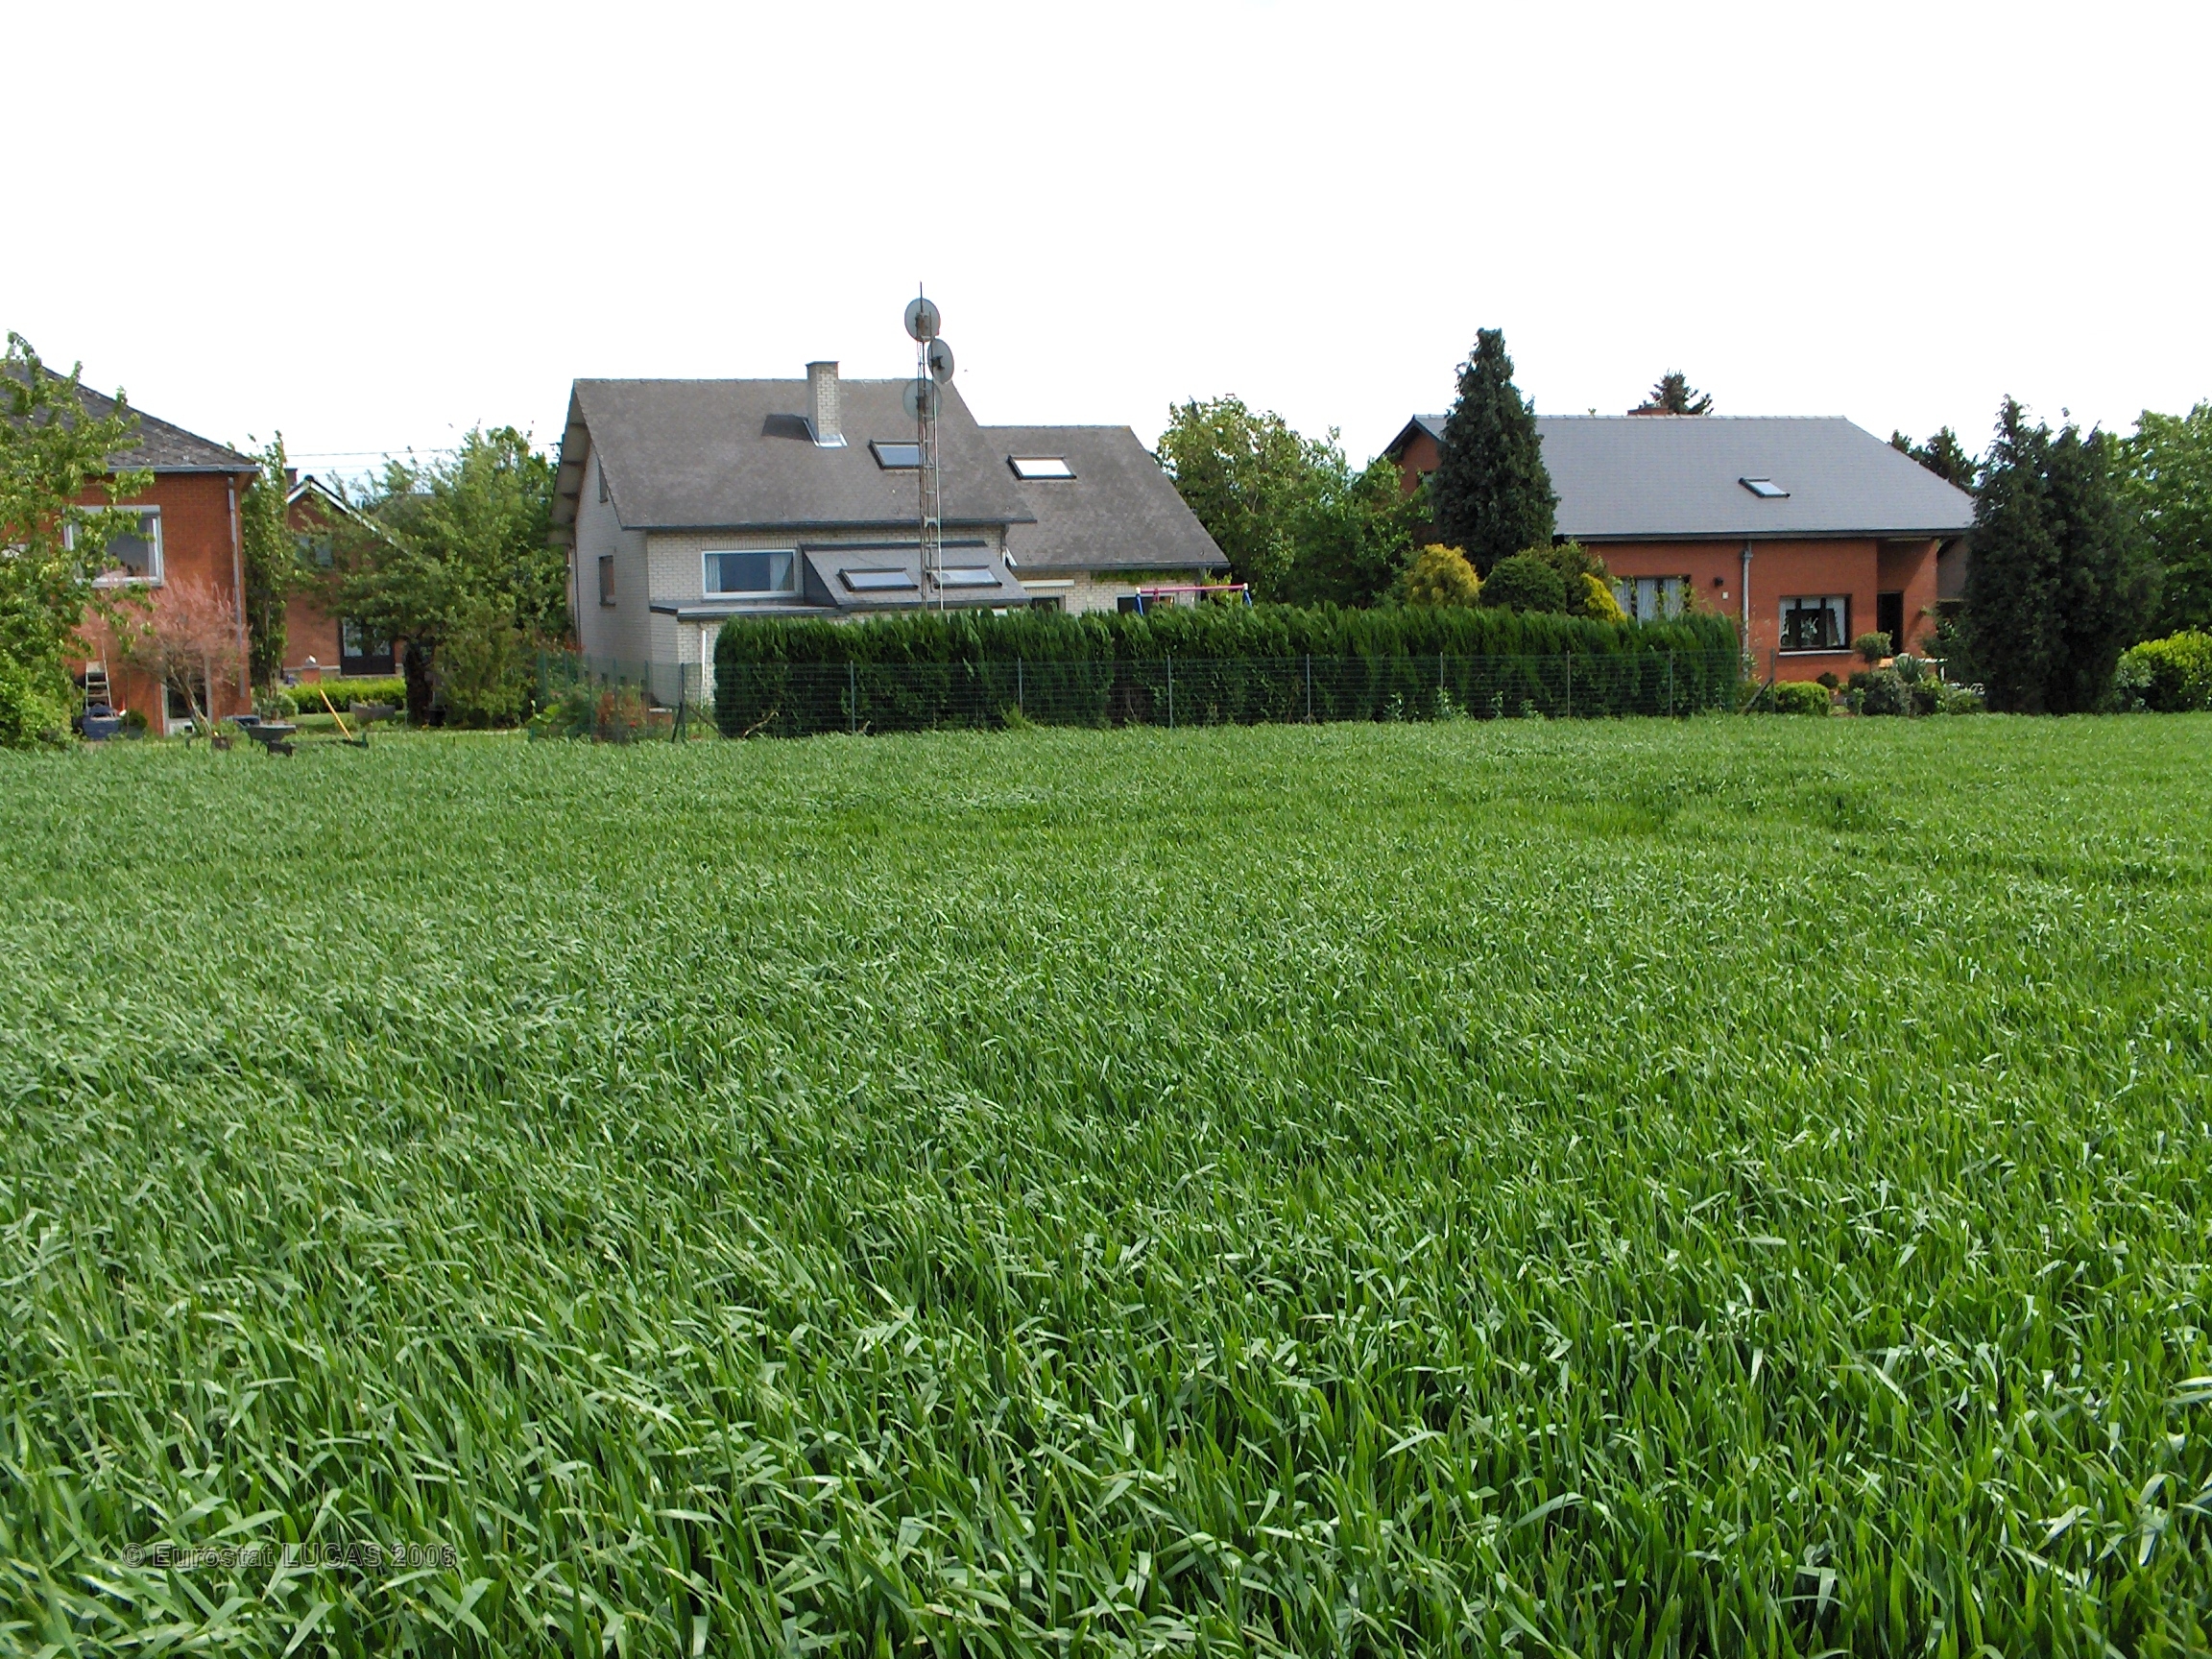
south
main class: Cropland
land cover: Common wheat
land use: Agriculture (excluding fallow land and kitchen gardens)
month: May
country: BE
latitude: 50.3606
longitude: 4.5560
